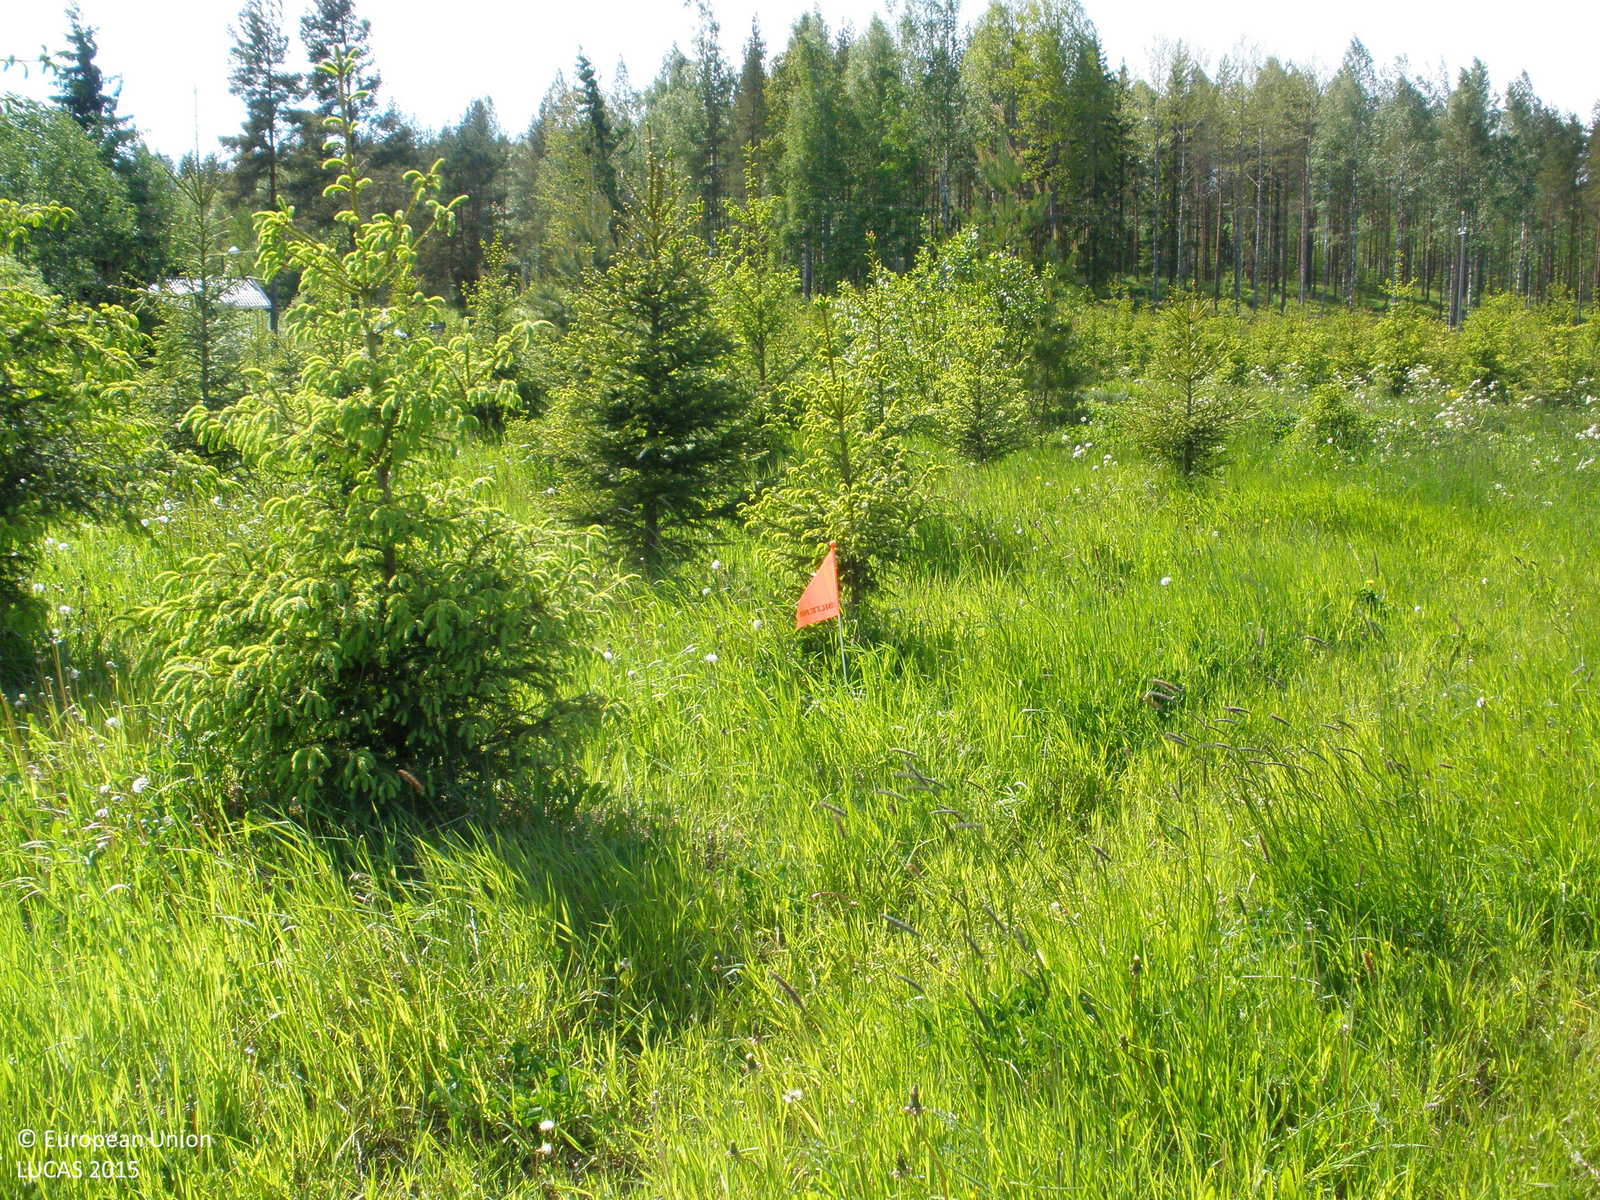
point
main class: Woodland
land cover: Spruce dominated coniferous woodland
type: boreal forest
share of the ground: 25 - 50 %
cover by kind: herbaceous plants 65 %, coniferous forest trees 35 %
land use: Forestry
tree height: < 5 m
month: June
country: FI
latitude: 60.7193
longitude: 23.4836
